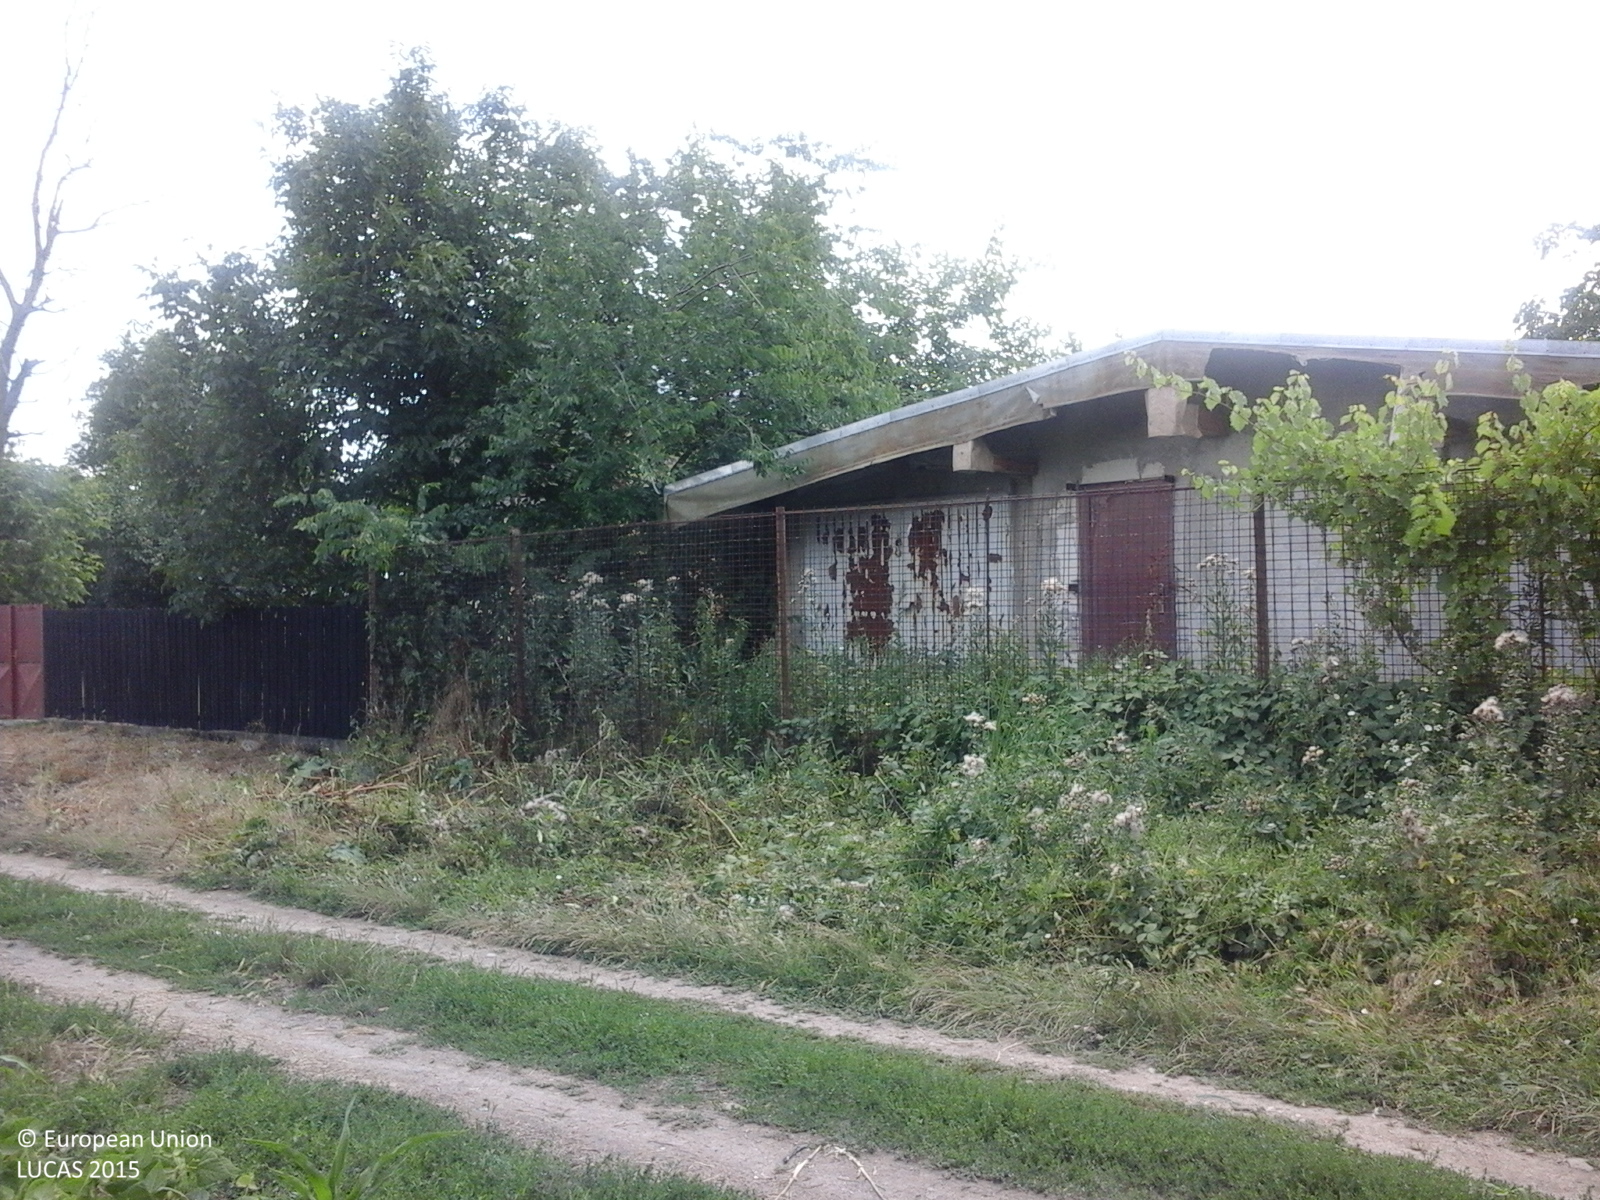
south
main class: Cropland
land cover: Dry pulses
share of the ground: > 75 %
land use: Kitchen garden
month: June
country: RO
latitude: 44.2766
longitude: 26.3345
